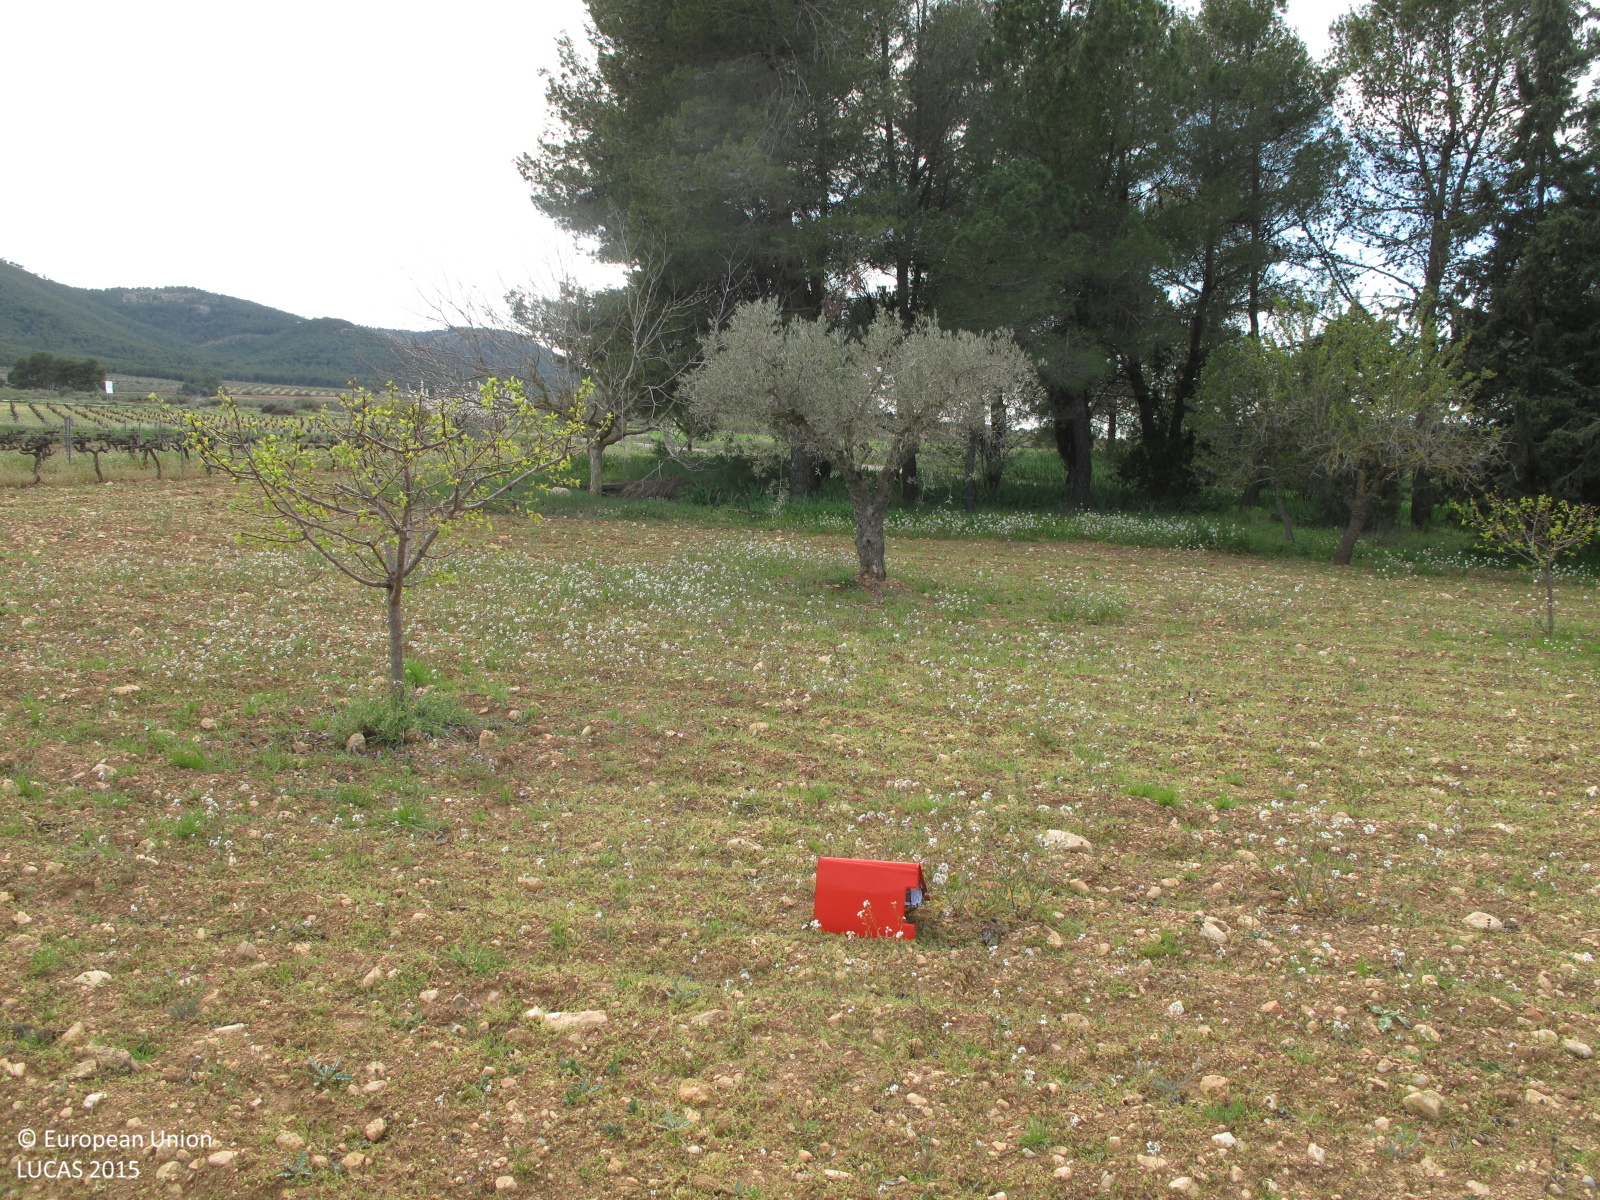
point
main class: Cropland
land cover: Cherry fruit
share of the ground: 10 - 25 %
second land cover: Other fruit trees and berries
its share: < 10 %
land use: Agriculture (excluding fallow land and kitchen gardens)
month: March
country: ES
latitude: 38.7802
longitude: -0.7544
